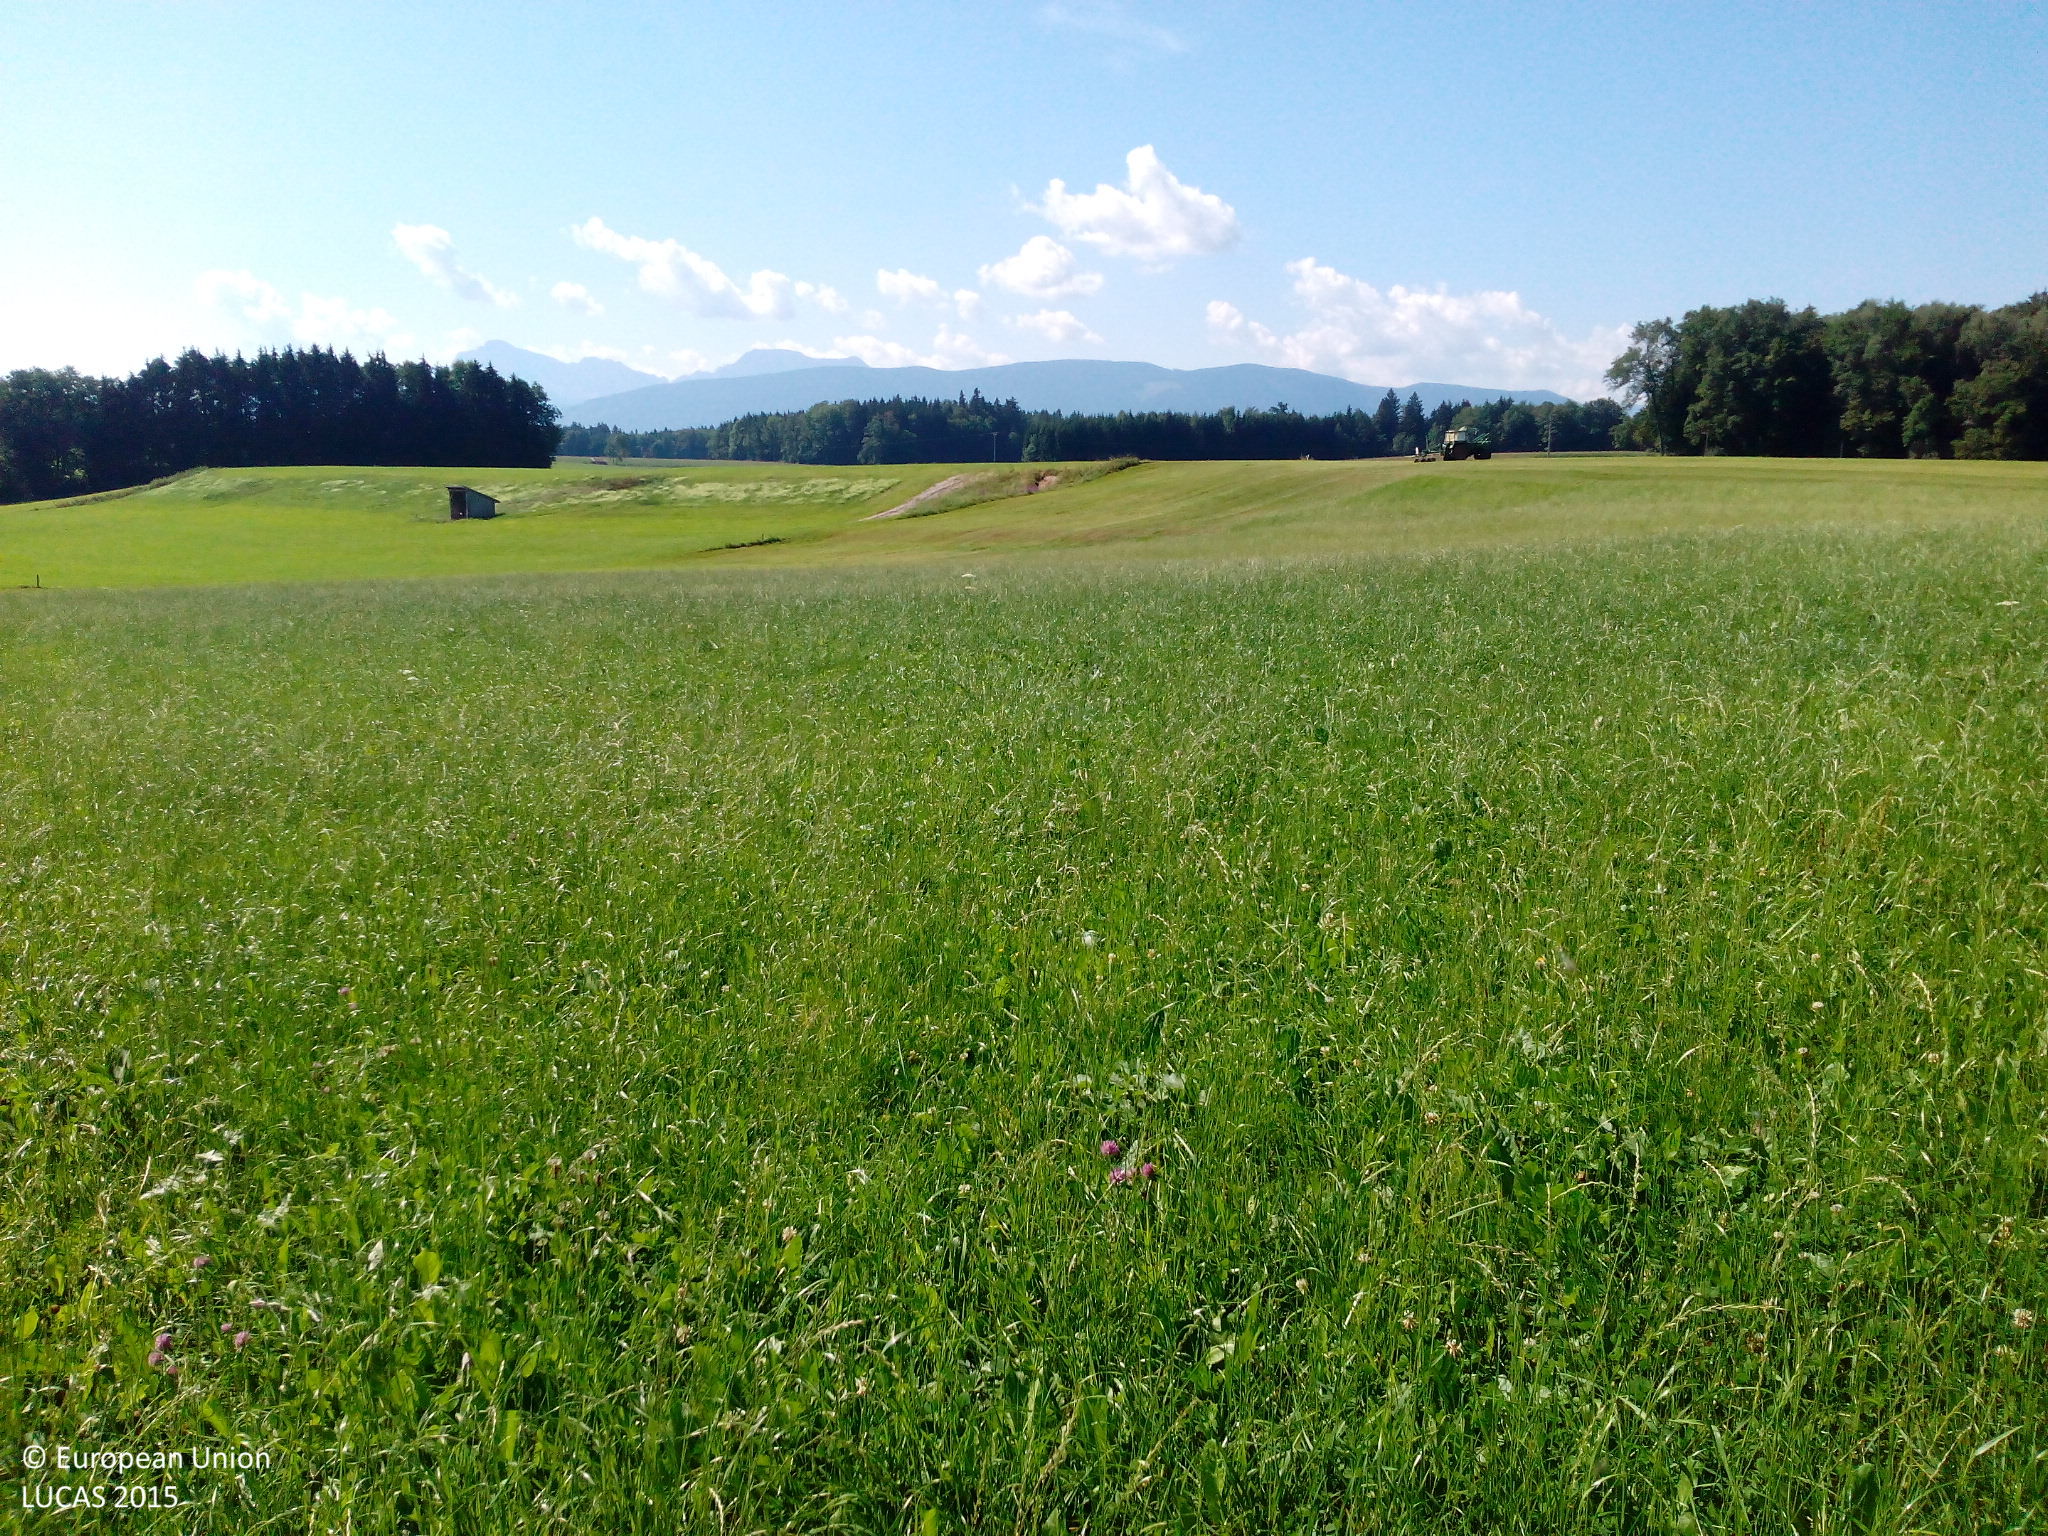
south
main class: Grassland
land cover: Grassland without tree/shrub cover
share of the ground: > 75 %
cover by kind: herbaceous plants 100 %
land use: Agriculture (excluding fallow land and kitchen gardens)
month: August
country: DE
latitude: 47.9000
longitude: 12.7944
